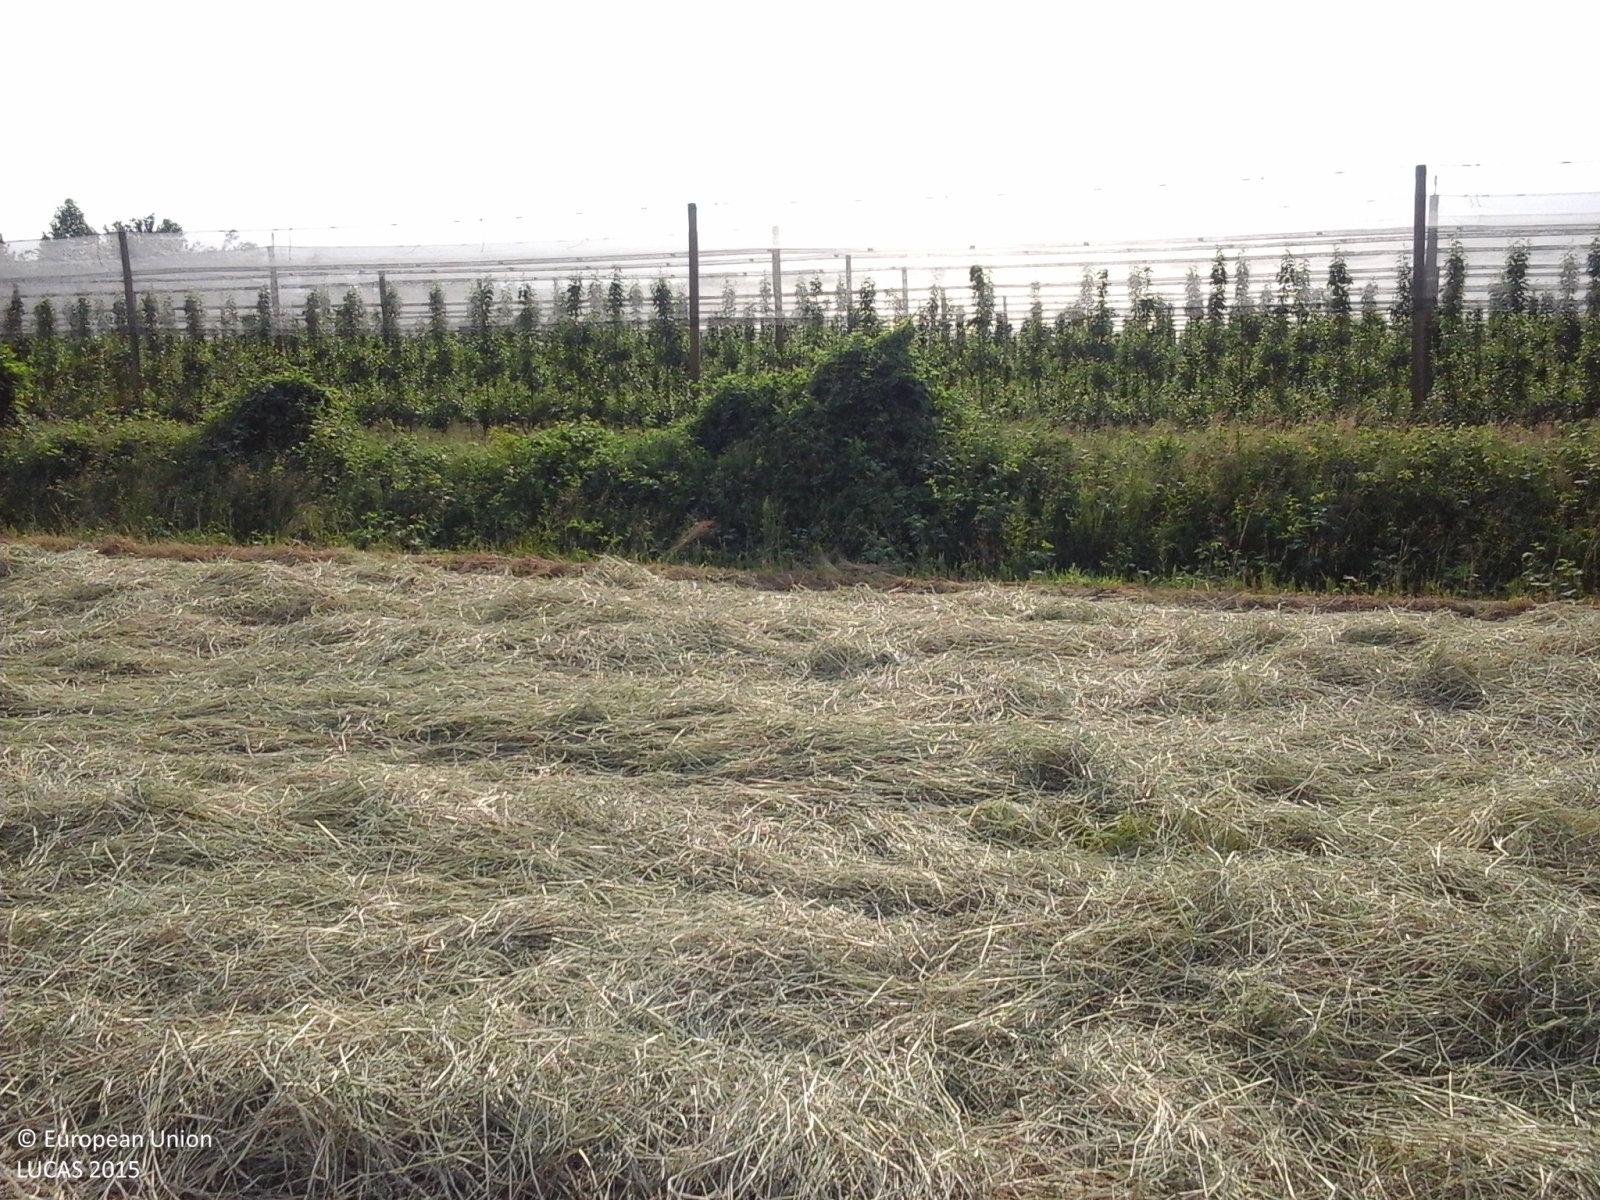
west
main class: Cropland
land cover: Temporary grasslands
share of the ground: > 75 %
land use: Agriculture (excluding fallow land and kitchen gardens)
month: May
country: IT
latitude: 45.2340
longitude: 10.0381
